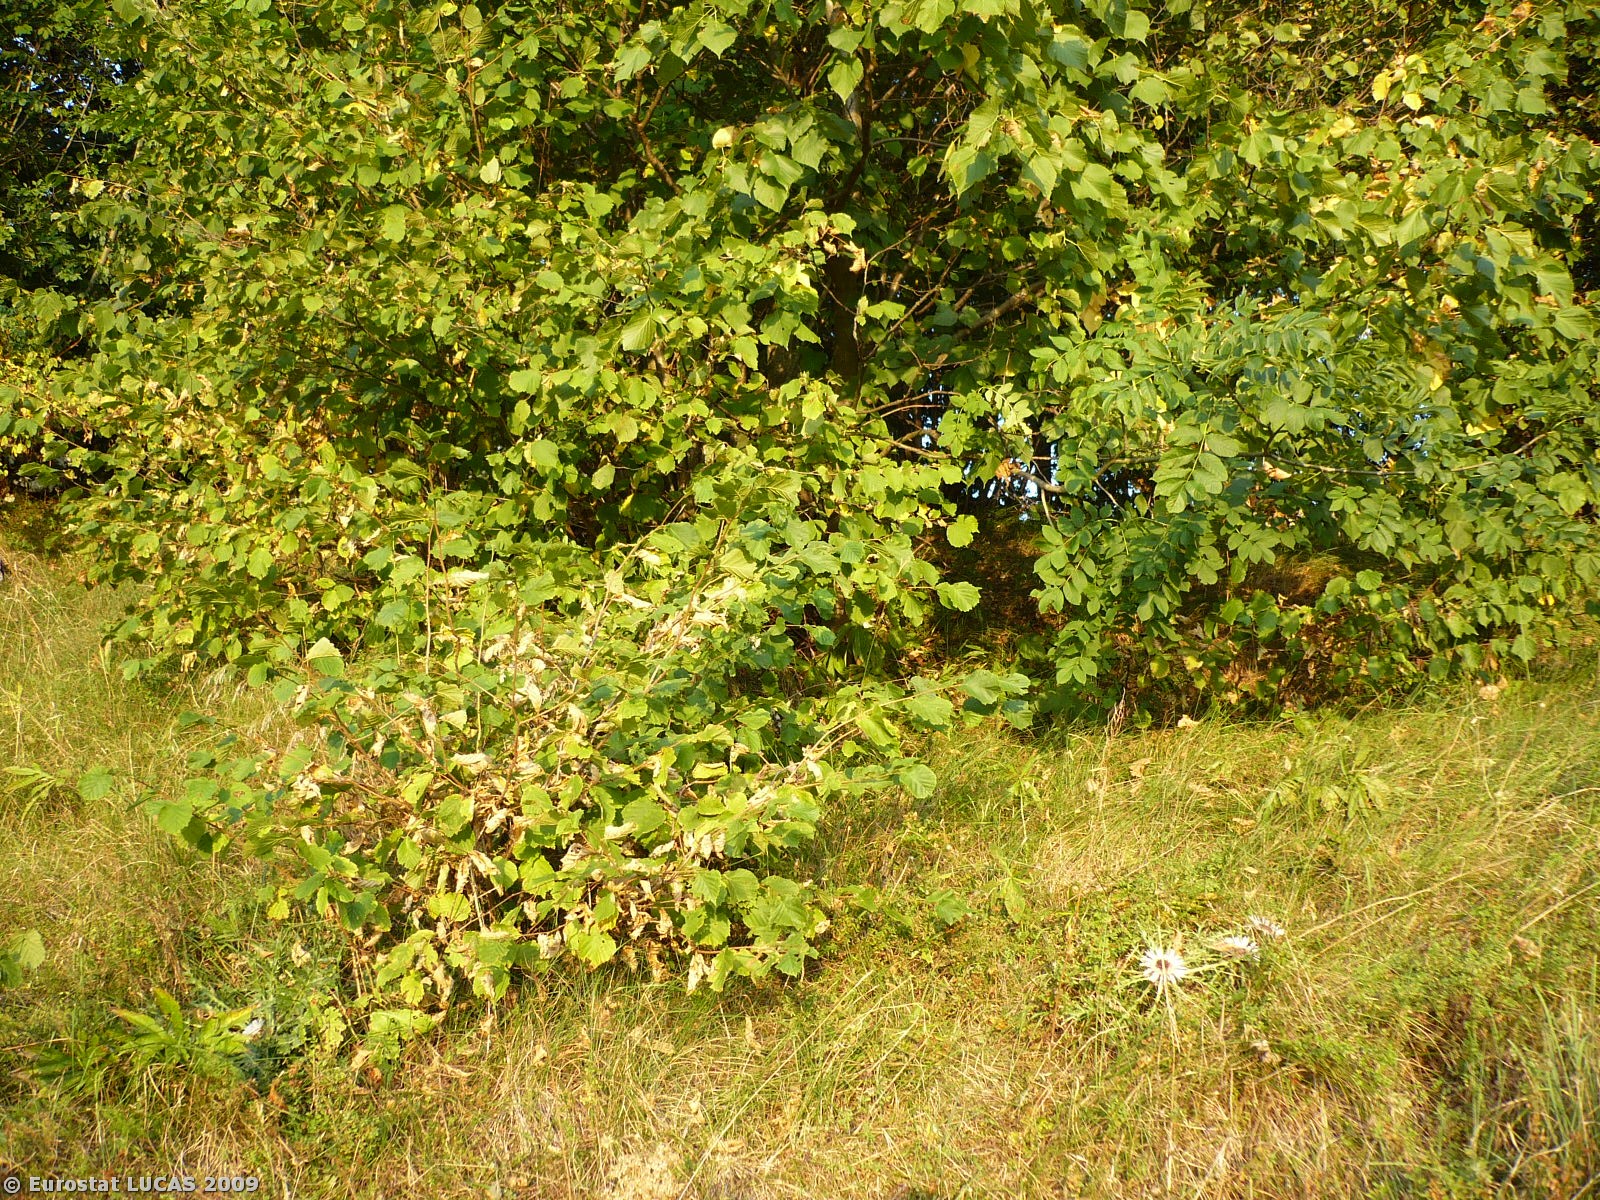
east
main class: Grassland
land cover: Grassland with sparse tree/shrub cover
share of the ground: > 75 %
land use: Fallow land
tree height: > 5 m
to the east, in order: Grassland with sparse tree/shrub cover; Broadleaved woodland; Dry stone walls; Broadleaved woodland; Tracks; Dry stone walls; Broadleaved woodland; Tracks; Broadleaved woodland; Fences; Grassland with sparse tree/shrub cover; Spontaneously vegetated surfaces; Grassland with sparse tree/shrub cover; Electric lines; Grassland with sparse tree/shrub cover; Fences; Grass margins; Paved roads, cycling and walking lanes; Artificial constructions; Grassland without tree/shrub cover; Fences; Grassland without tree/shrub cover; Broadleaved woodland; Ditches and canals; Broadleaved woodland; Fences; Grassland with sparse tree/shrub cover
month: August
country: SI
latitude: 46.2343
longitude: 13.6663
